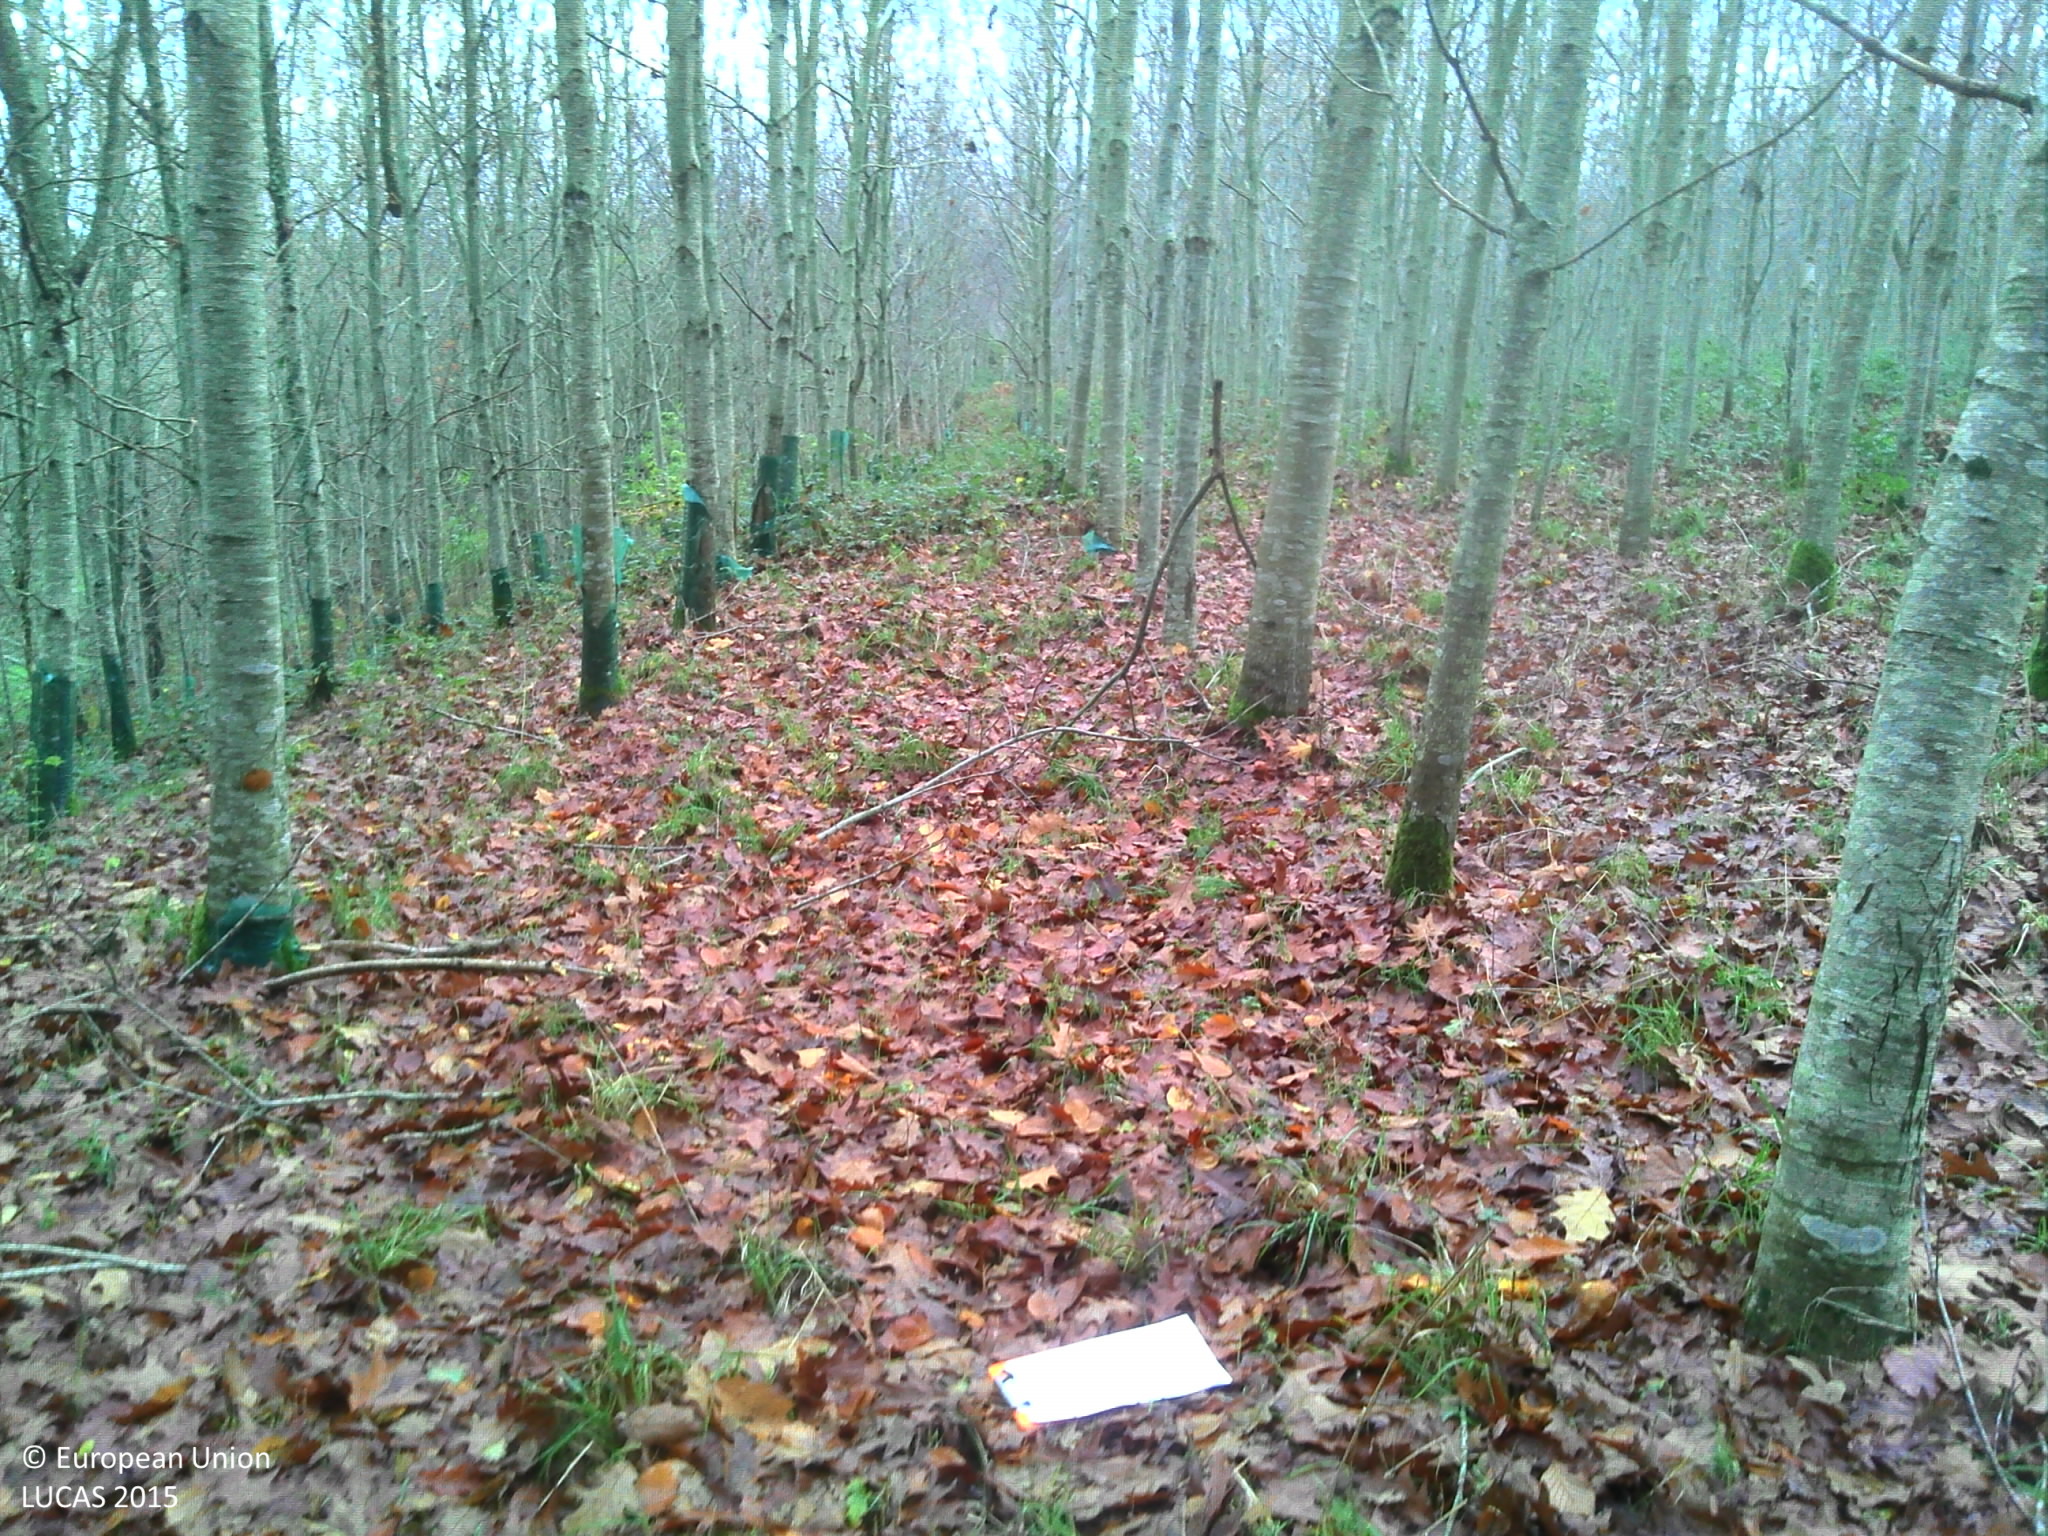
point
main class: Woodland
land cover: Broadleaved woodland
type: exotic forest
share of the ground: > 75 %
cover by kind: broadleaved forest trees 100 %
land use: Forestry
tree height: > 5 m
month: November
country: FR
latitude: 48.0111
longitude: -3.3316
